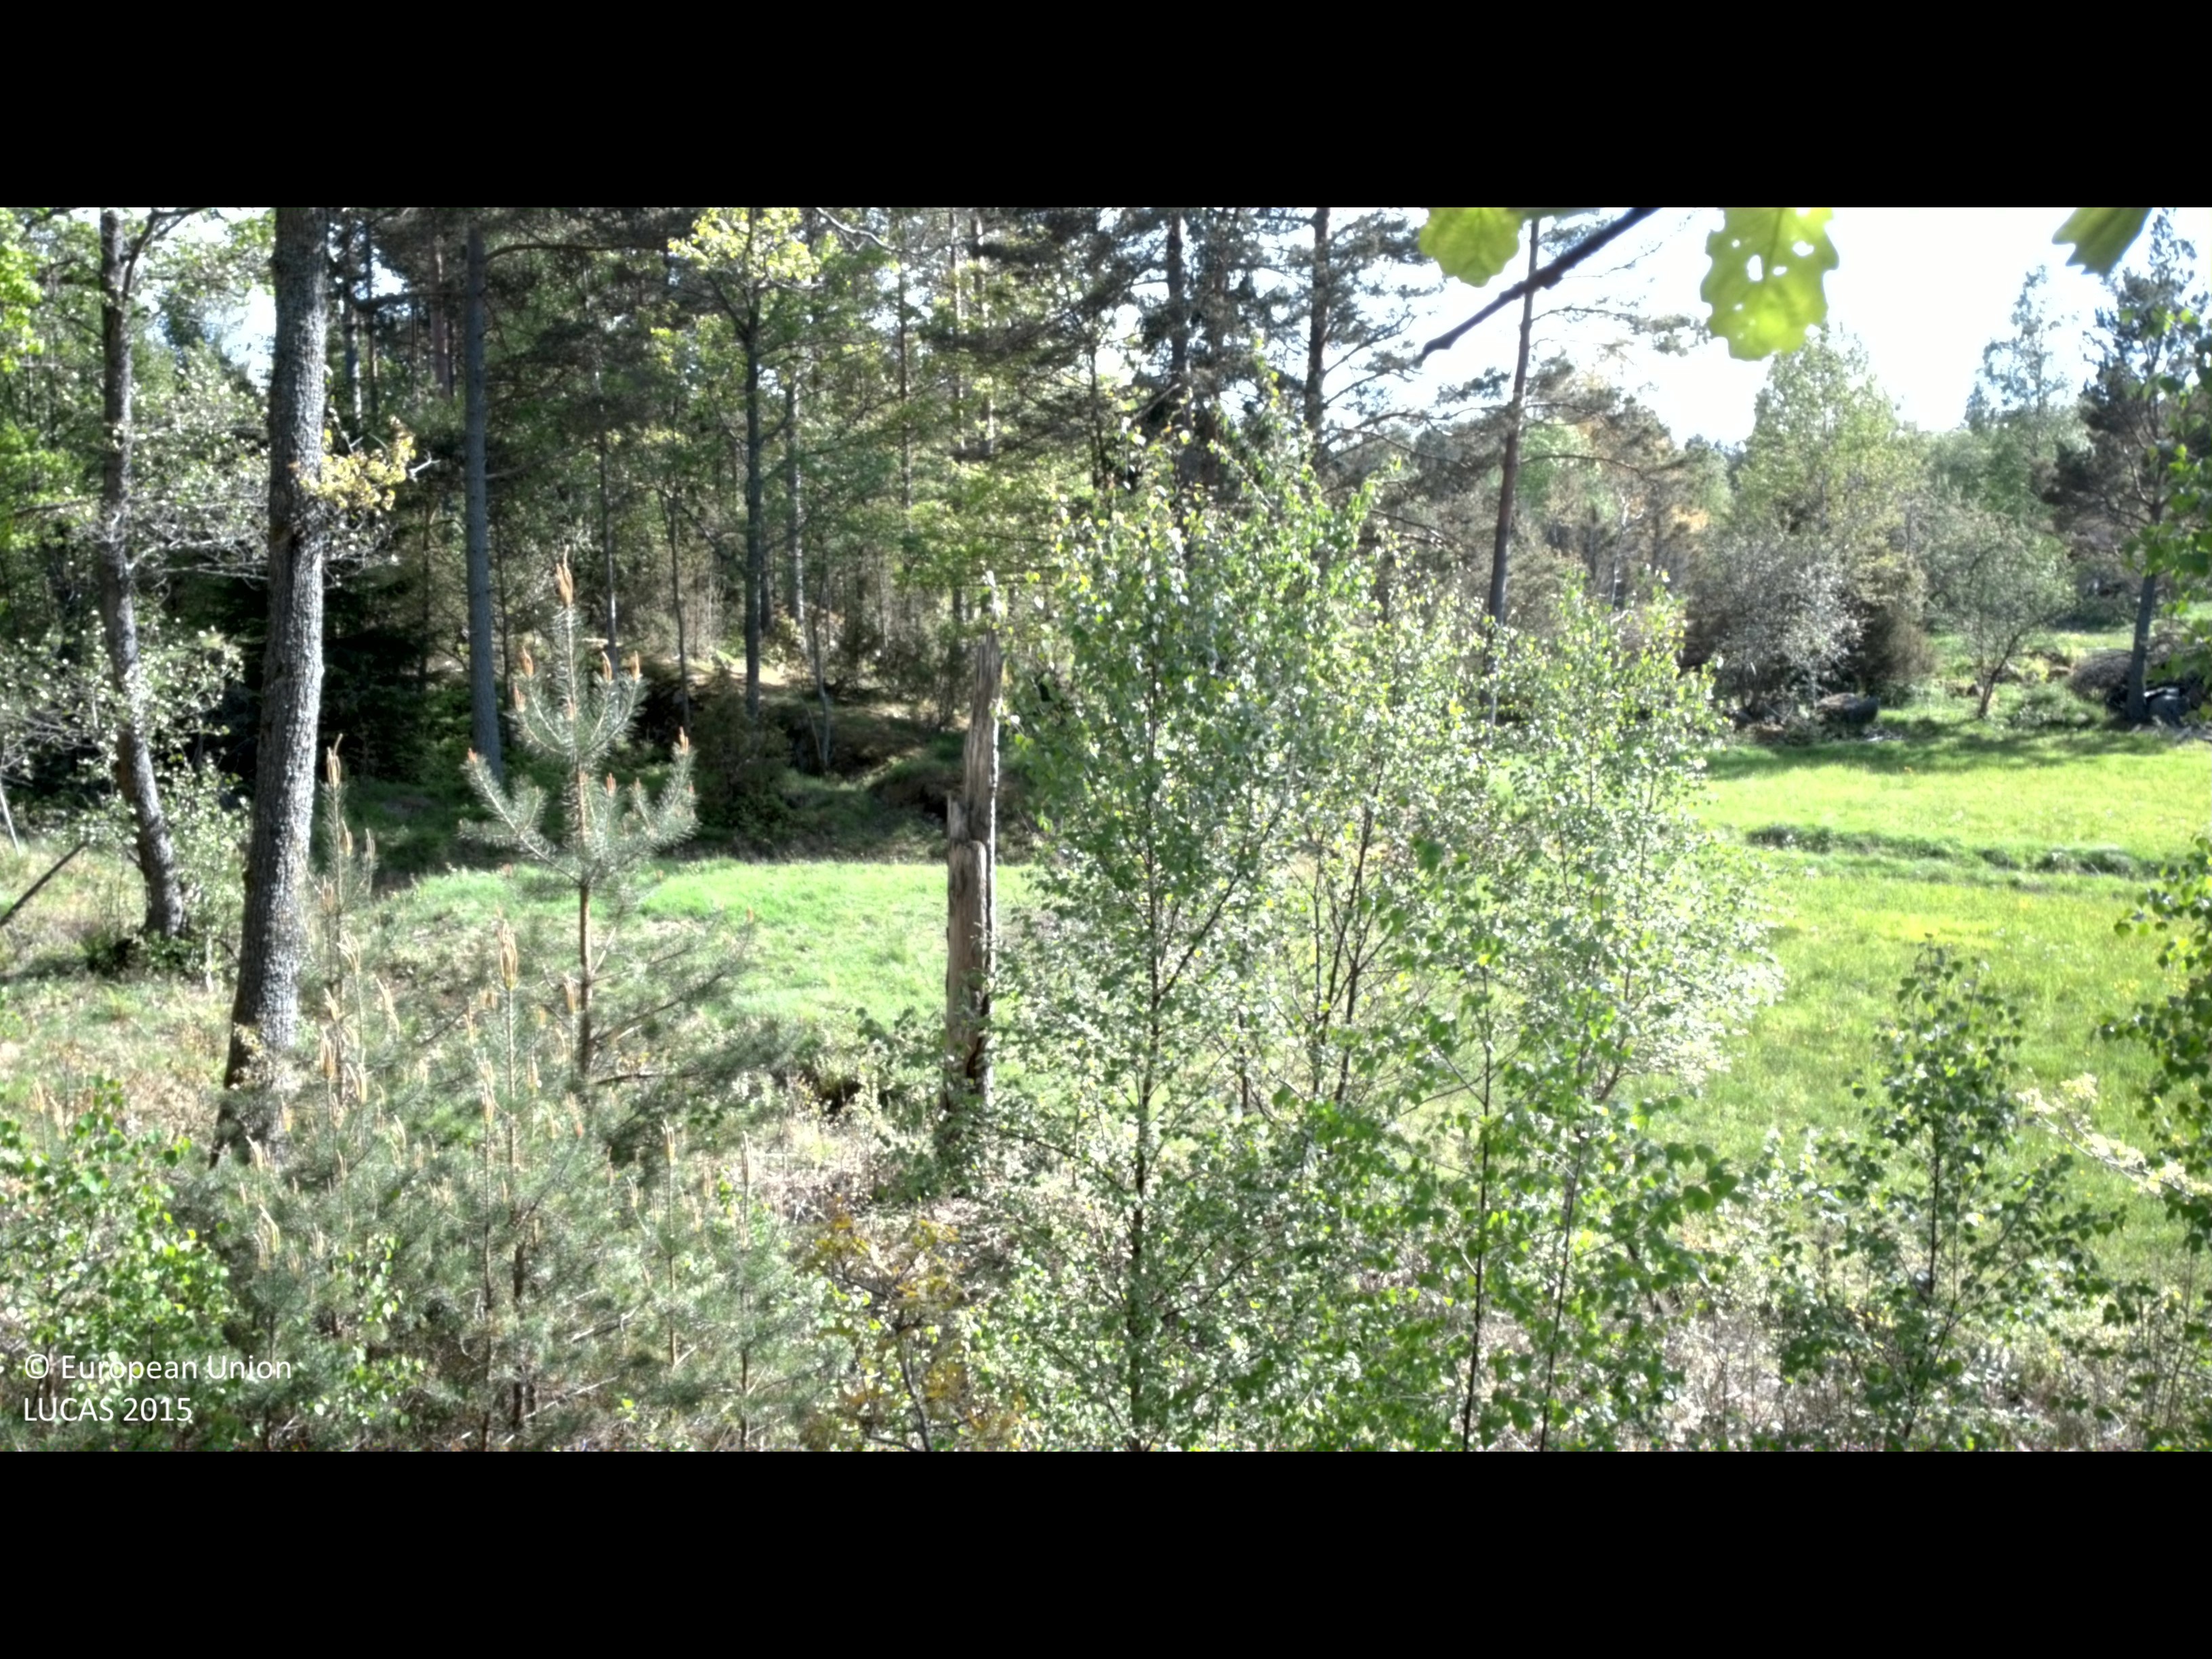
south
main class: Woodland
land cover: Broadleaved woodland
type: boreal forest
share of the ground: 25 - 50 %
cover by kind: broadleaved forest trees 45 %, shrubs 15 %, consolidated bare surface 15 %, herbaceous plants 10 %, lichens and mosses 10 %, coniferous forest trees 5 %
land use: Forestry
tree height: > 5 m
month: June
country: SE
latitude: 57.6186
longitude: 16.3434
